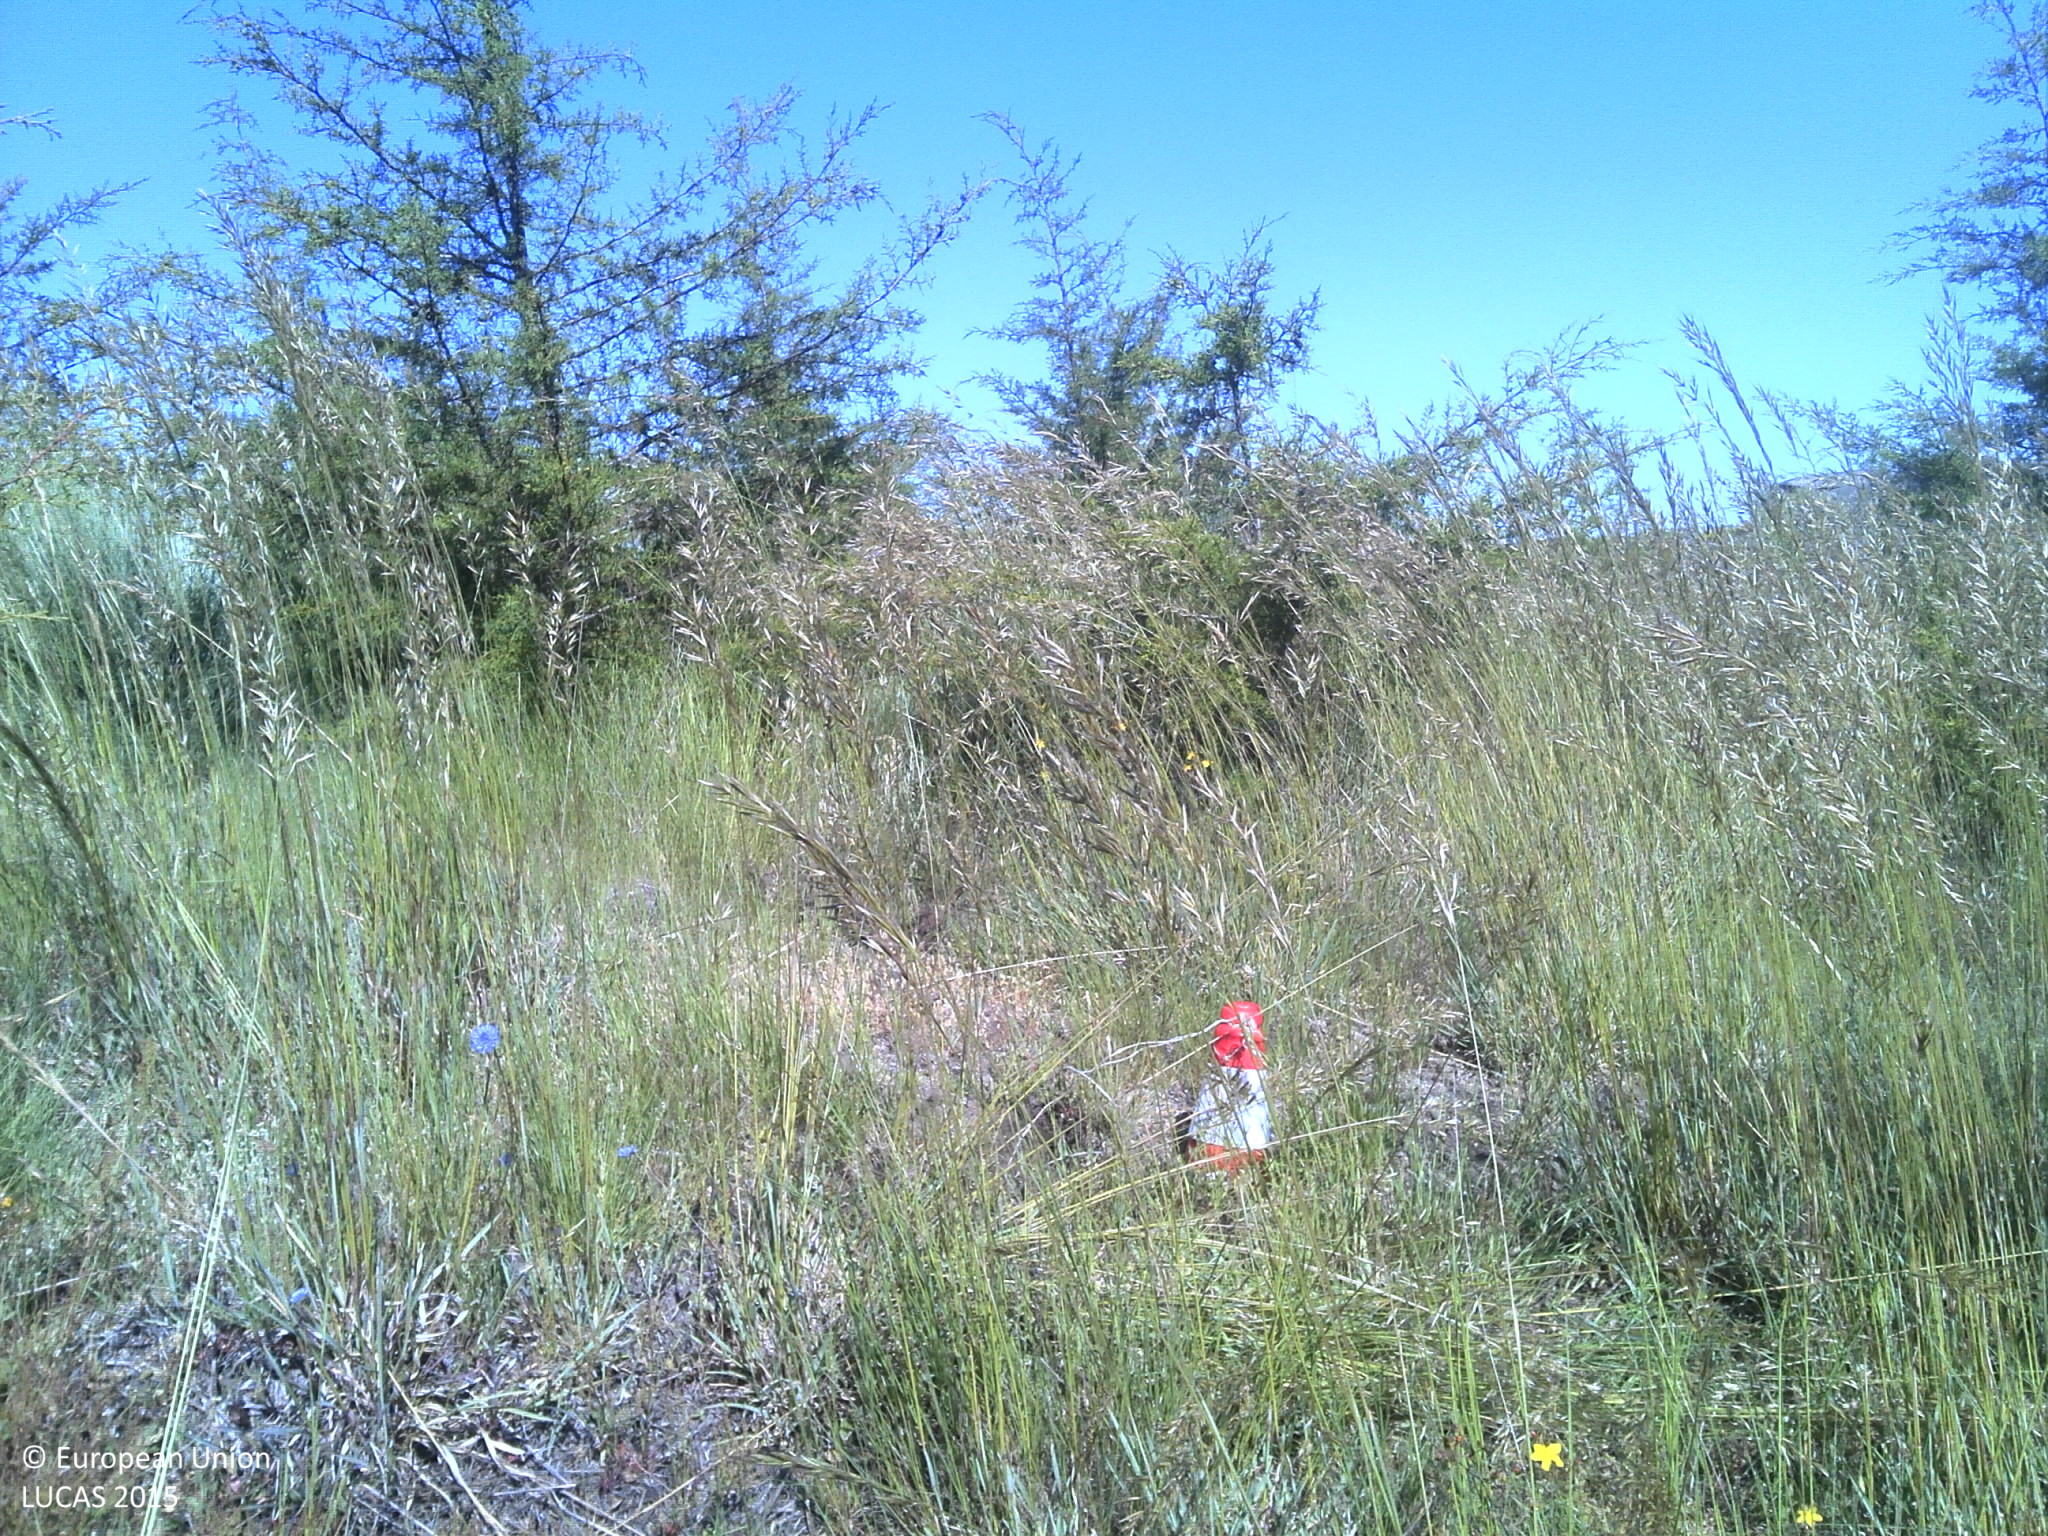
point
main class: Woodland
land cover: Other coniferous woodland
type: coniferous forest of the mediterranean region
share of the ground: 10 - 25 %
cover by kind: coniferous forest trees 25 %, shrubs 25 %, consolidated bare surface 25 %, herbaceous plants 20 %, unconsolidated bare surface 5 %
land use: Forestry
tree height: < 5 m
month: May
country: PT
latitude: 40.6015
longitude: -7.1813
